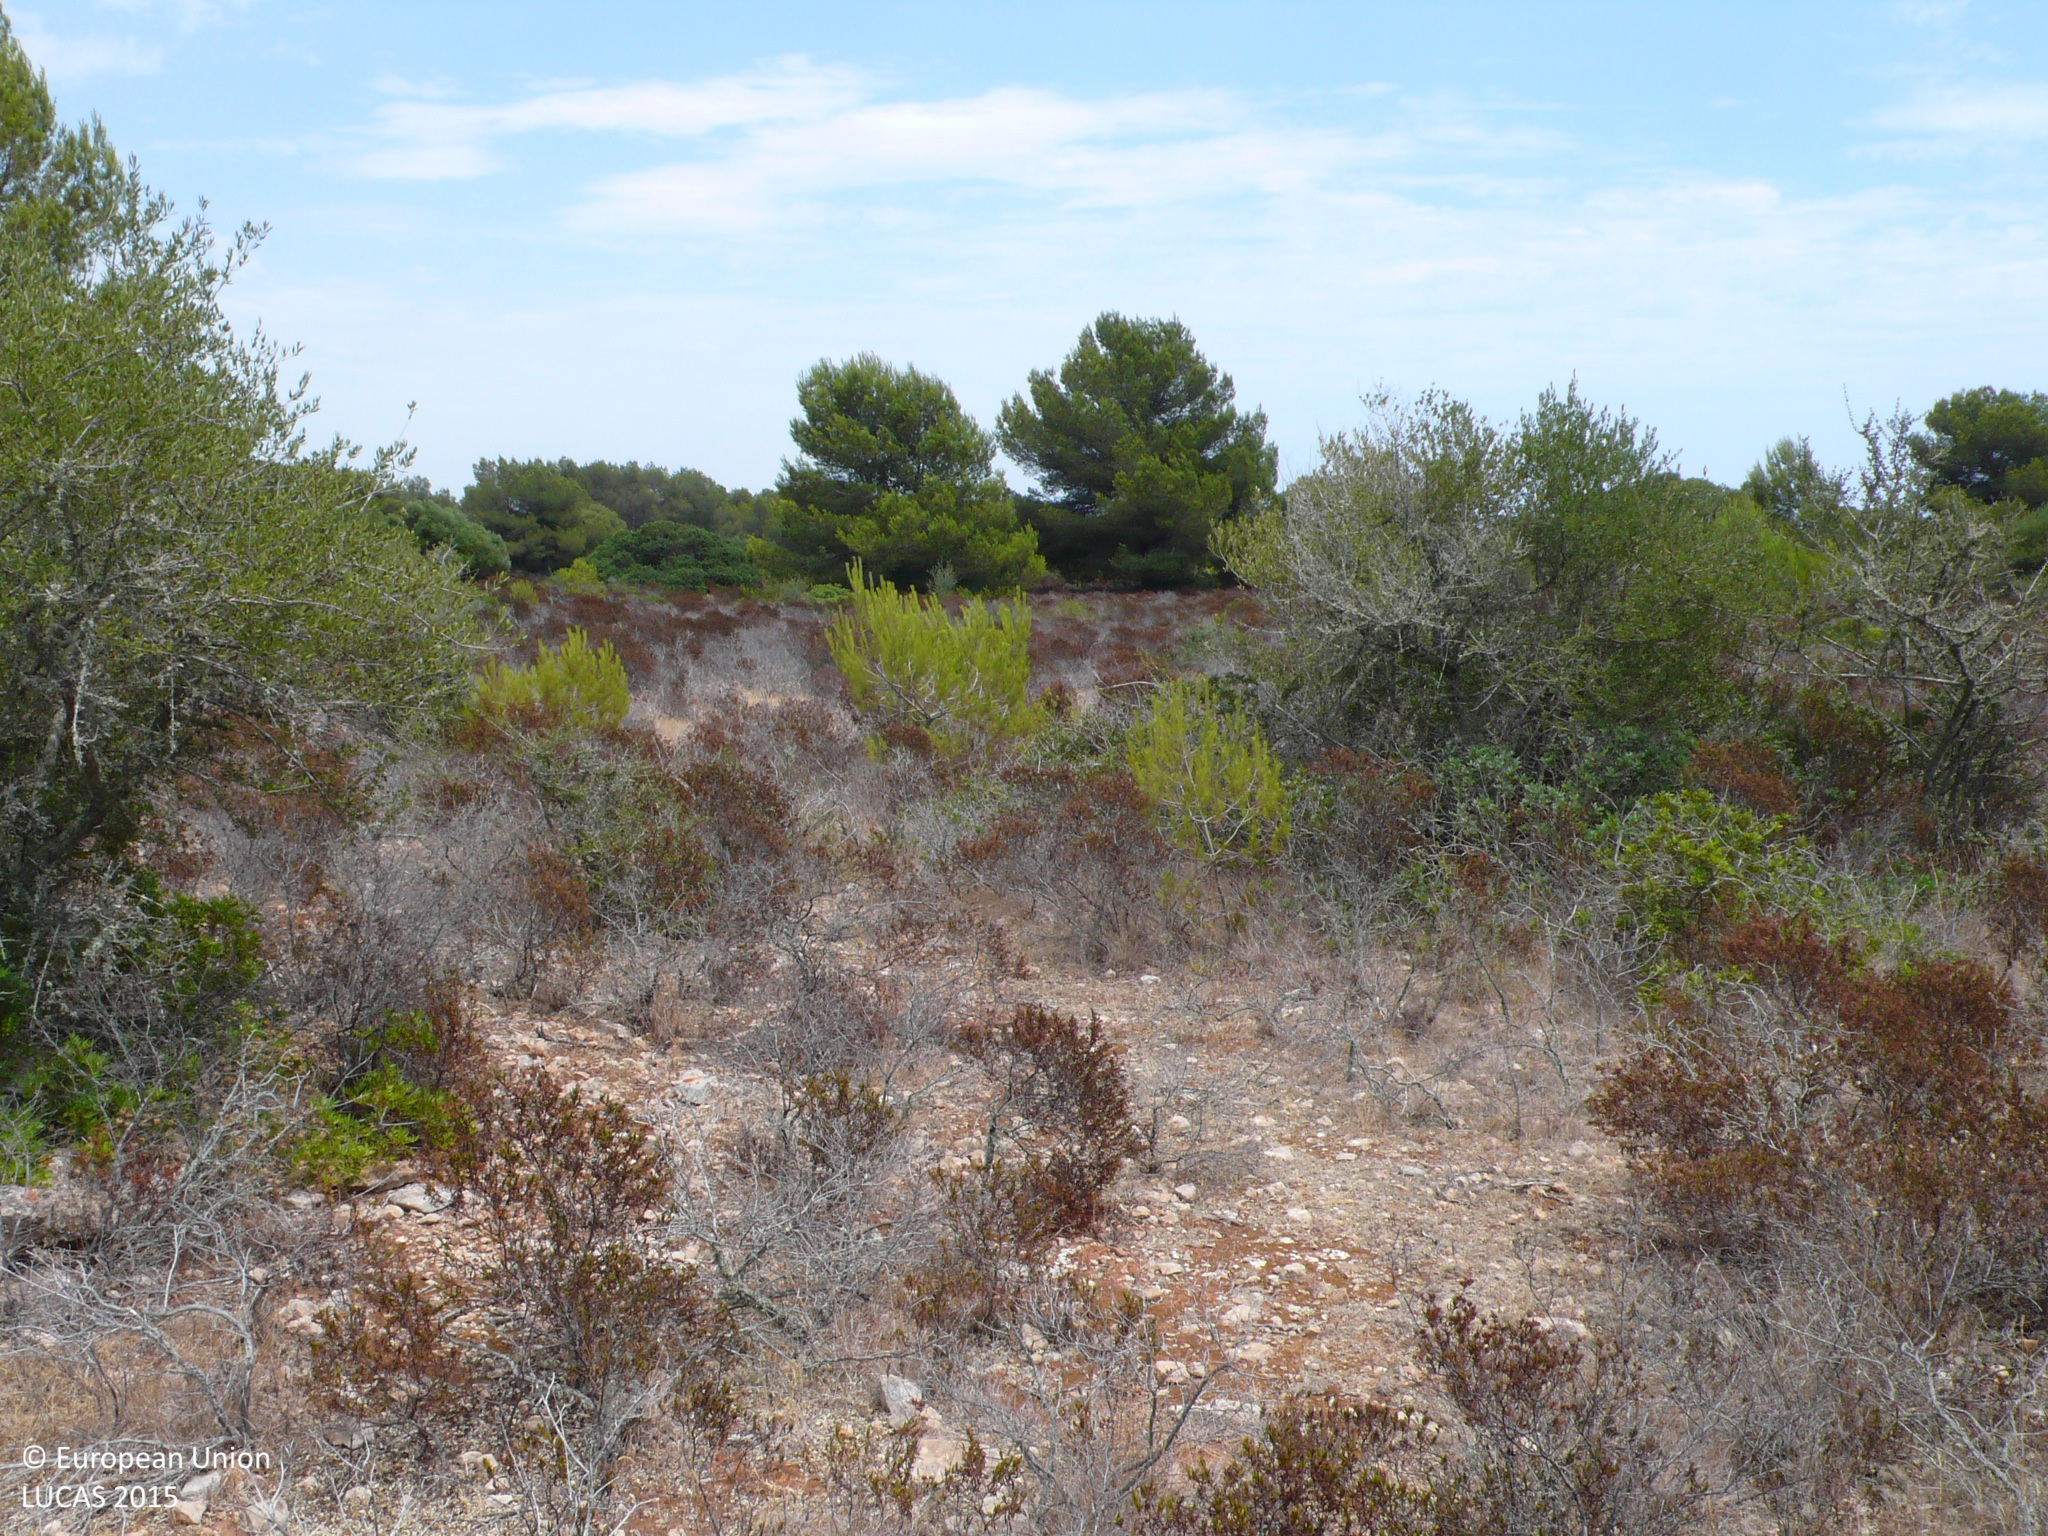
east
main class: Woodland
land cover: Pine dominated mixed woodland
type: coniferous forest of the mediterranean region
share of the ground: 10 - 25 %
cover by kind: shrubs 60 %, coniferous forest trees 20 %, broadleaved forest trees 15 %, consolidated bare surface 5 %
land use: Semi-natural and natural areas not in use
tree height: > 5 m
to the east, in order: Pine dominated mixed woodland; Shrubland with sparse tree cover; Pine dominated mixed woodland; Grassland with sparse tree/shrub cover; Tracks; Grassland with sparse tree/shrub cover; Broadleaved woodland
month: July
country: ES
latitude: 39.3683
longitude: 2.8238
